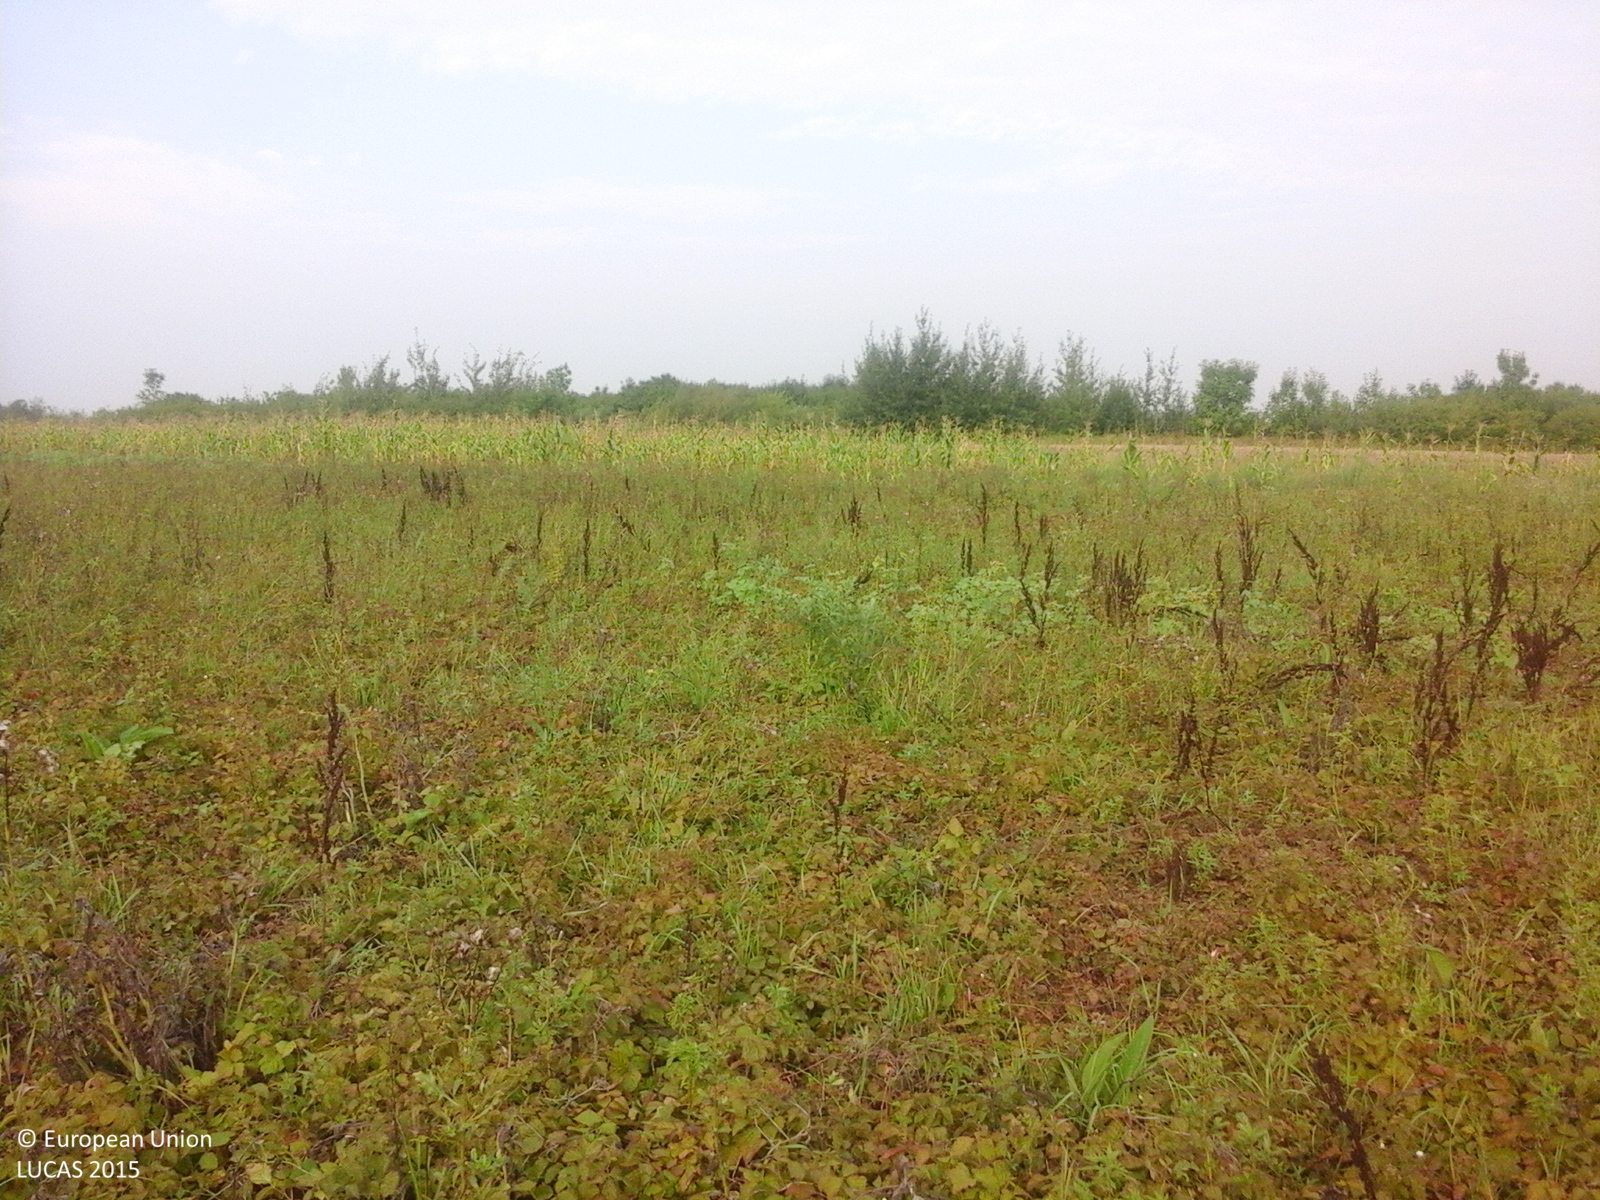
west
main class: Grassland
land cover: Spontaneously vegetated surfaces
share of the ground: > 75 %
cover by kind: herbaceous plants 100 %
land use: Fallow land
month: August
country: RO
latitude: 46.4122
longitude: 21.7357
